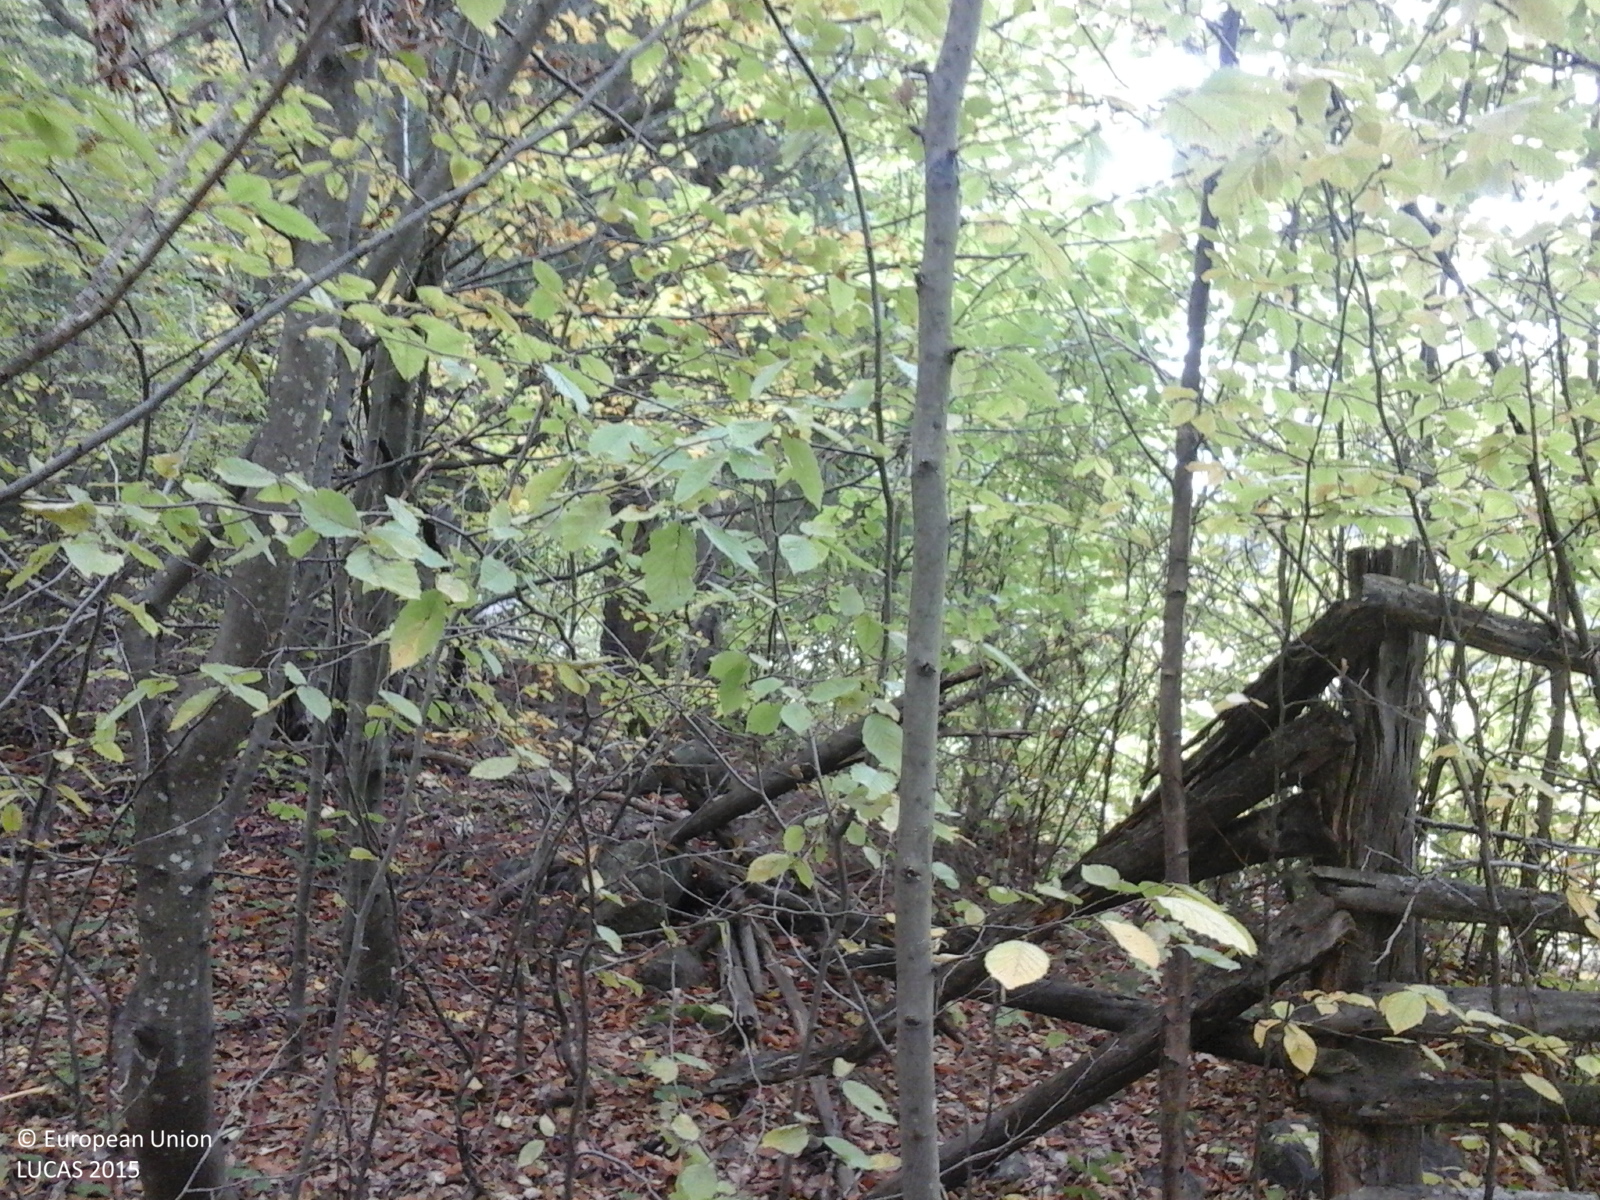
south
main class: Woodland
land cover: Broadleaved woodland
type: beech forest
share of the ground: > 75 %
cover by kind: broadleaved forest trees 100 %
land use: Forestry
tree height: > 5 m
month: October
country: RO
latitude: 46.4609
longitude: 25.4859
